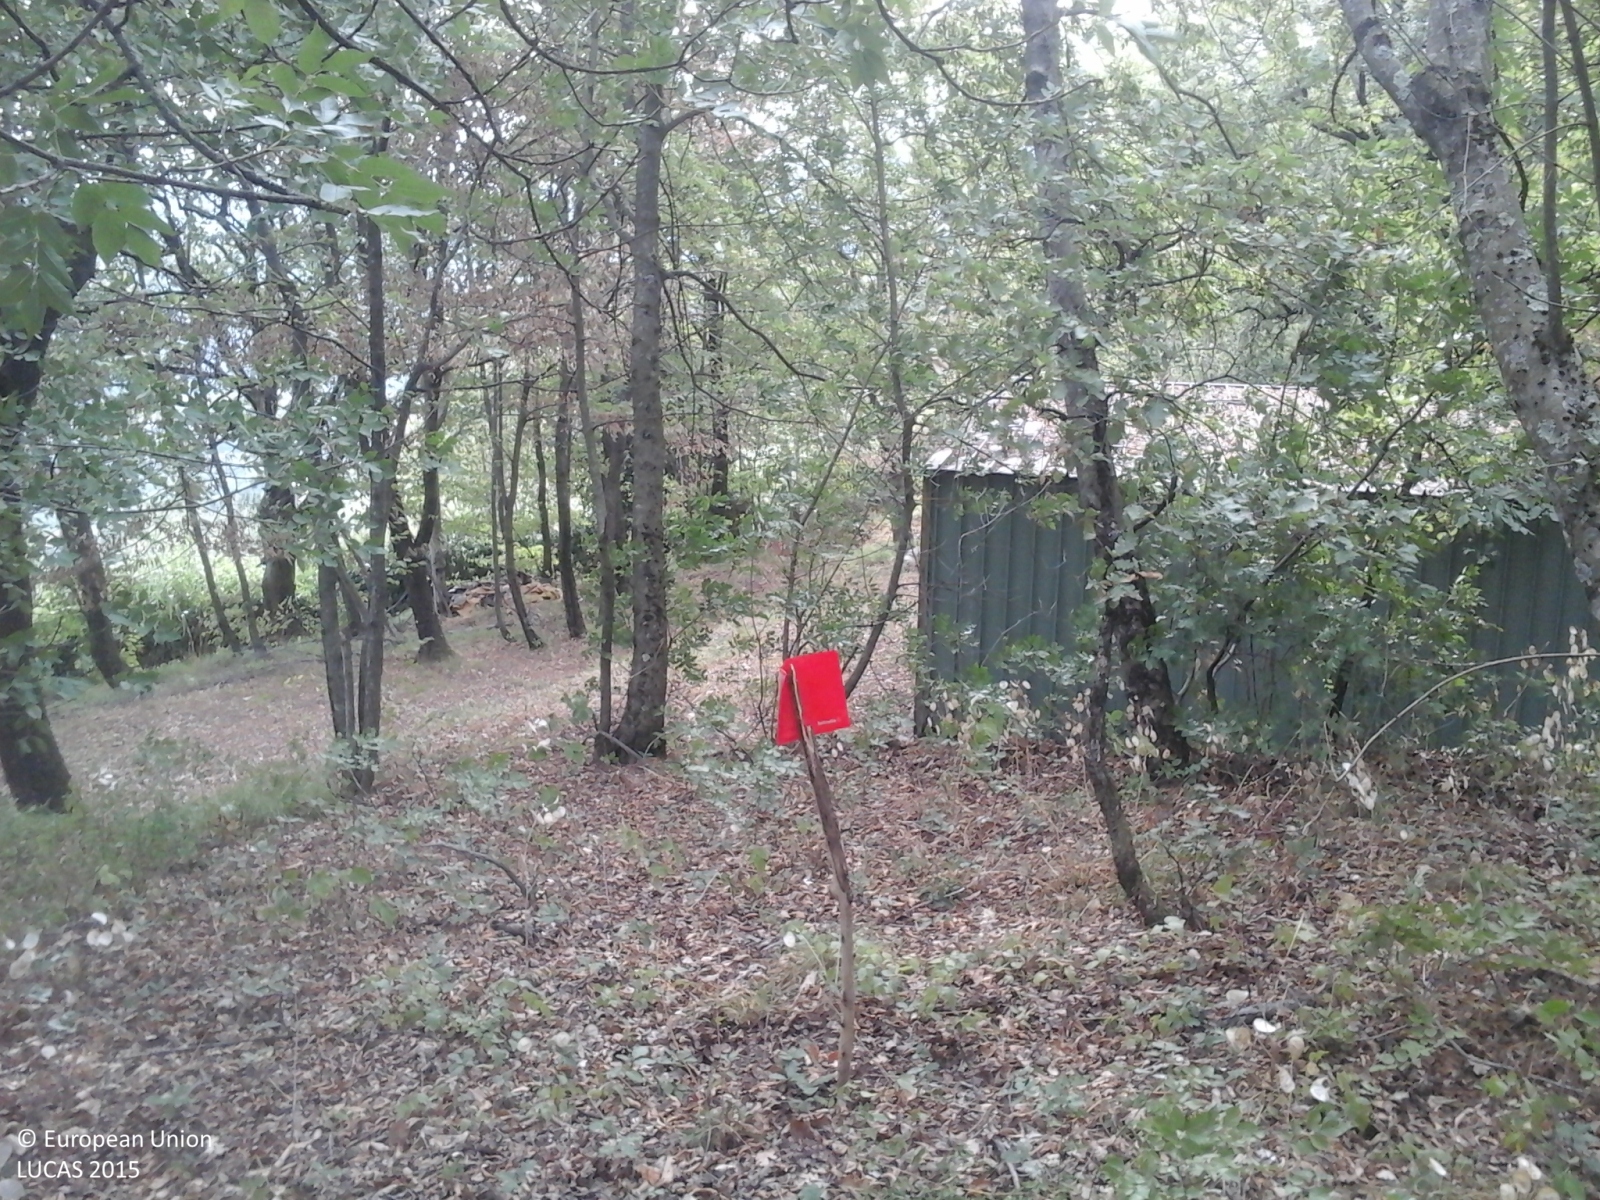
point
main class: Woodland
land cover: Broadleaved woodland
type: thermophilous deciduous forest
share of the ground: > 75 %
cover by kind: broadleaved forest trees 100 %
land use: Forestry
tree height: > 5 m
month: August
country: IT
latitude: 44.0038
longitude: 10.9082
